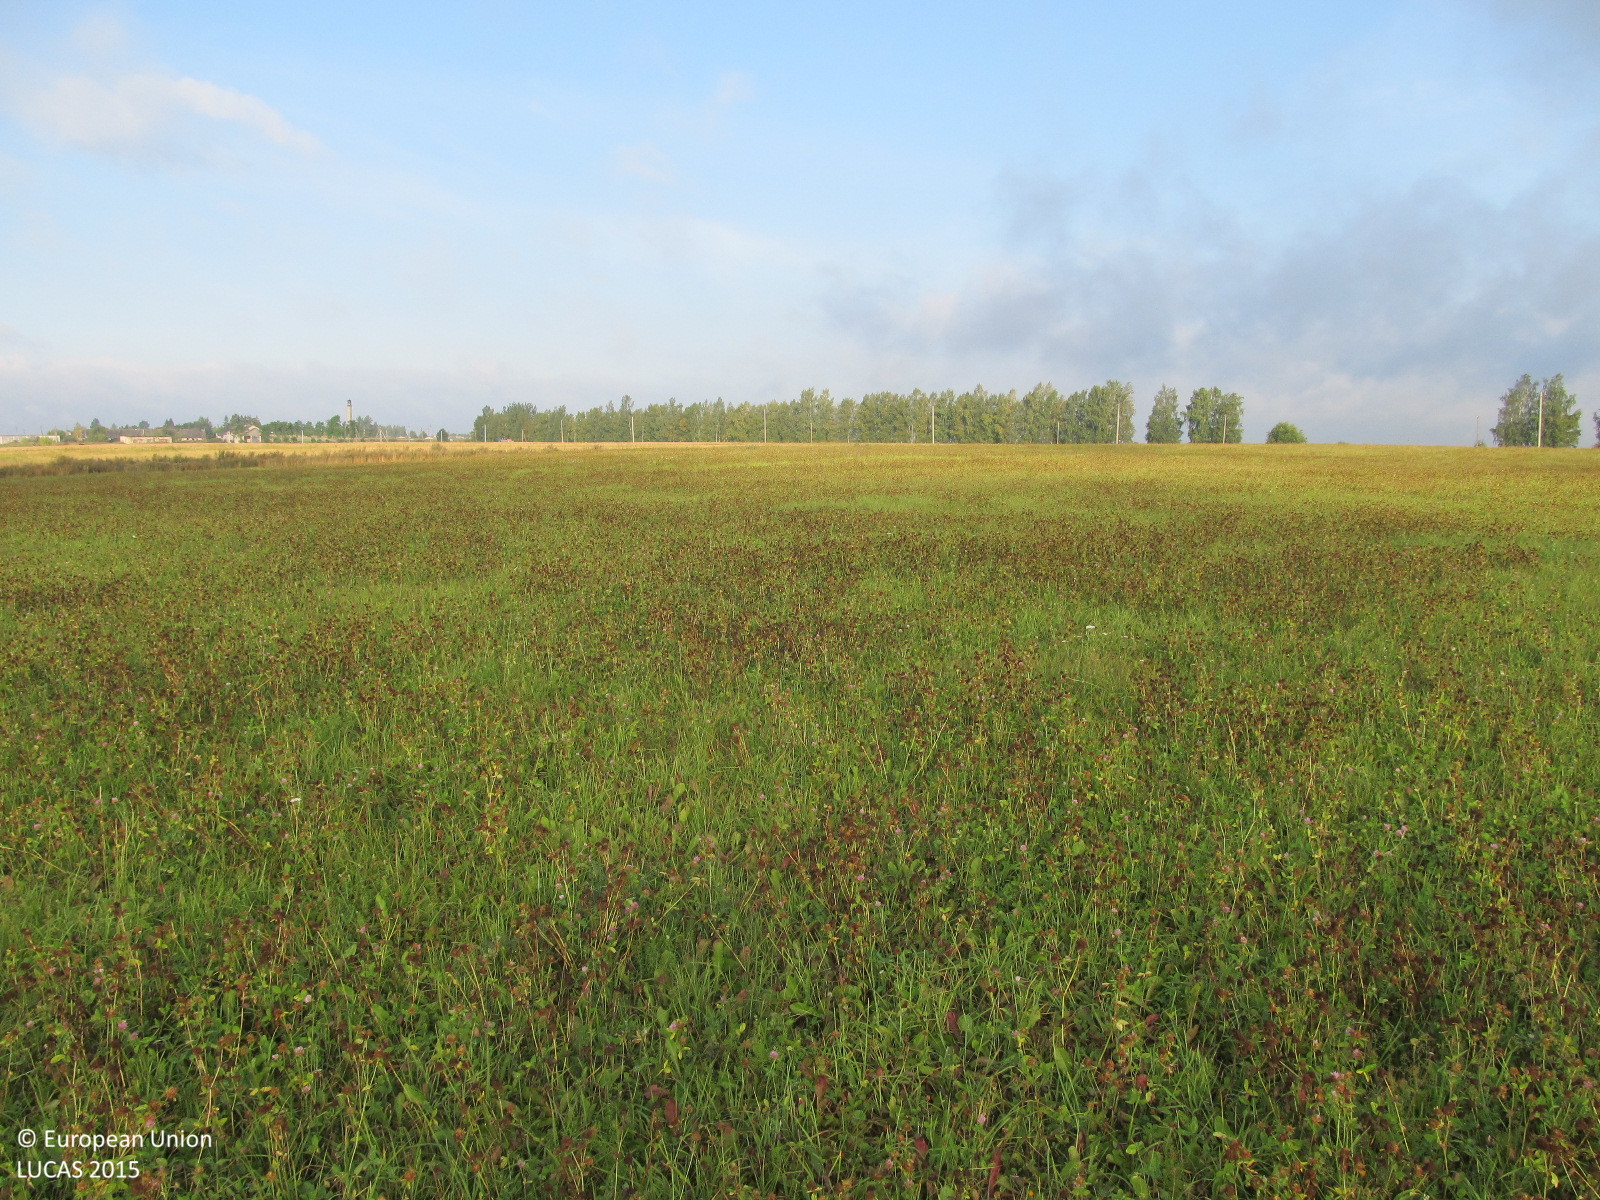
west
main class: Cropland
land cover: Clovers
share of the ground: > 75 %
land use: Agriculture (excluding fallow land and kitchen gardens)
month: August
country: LT
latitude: 55.6574
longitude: 23.2824
